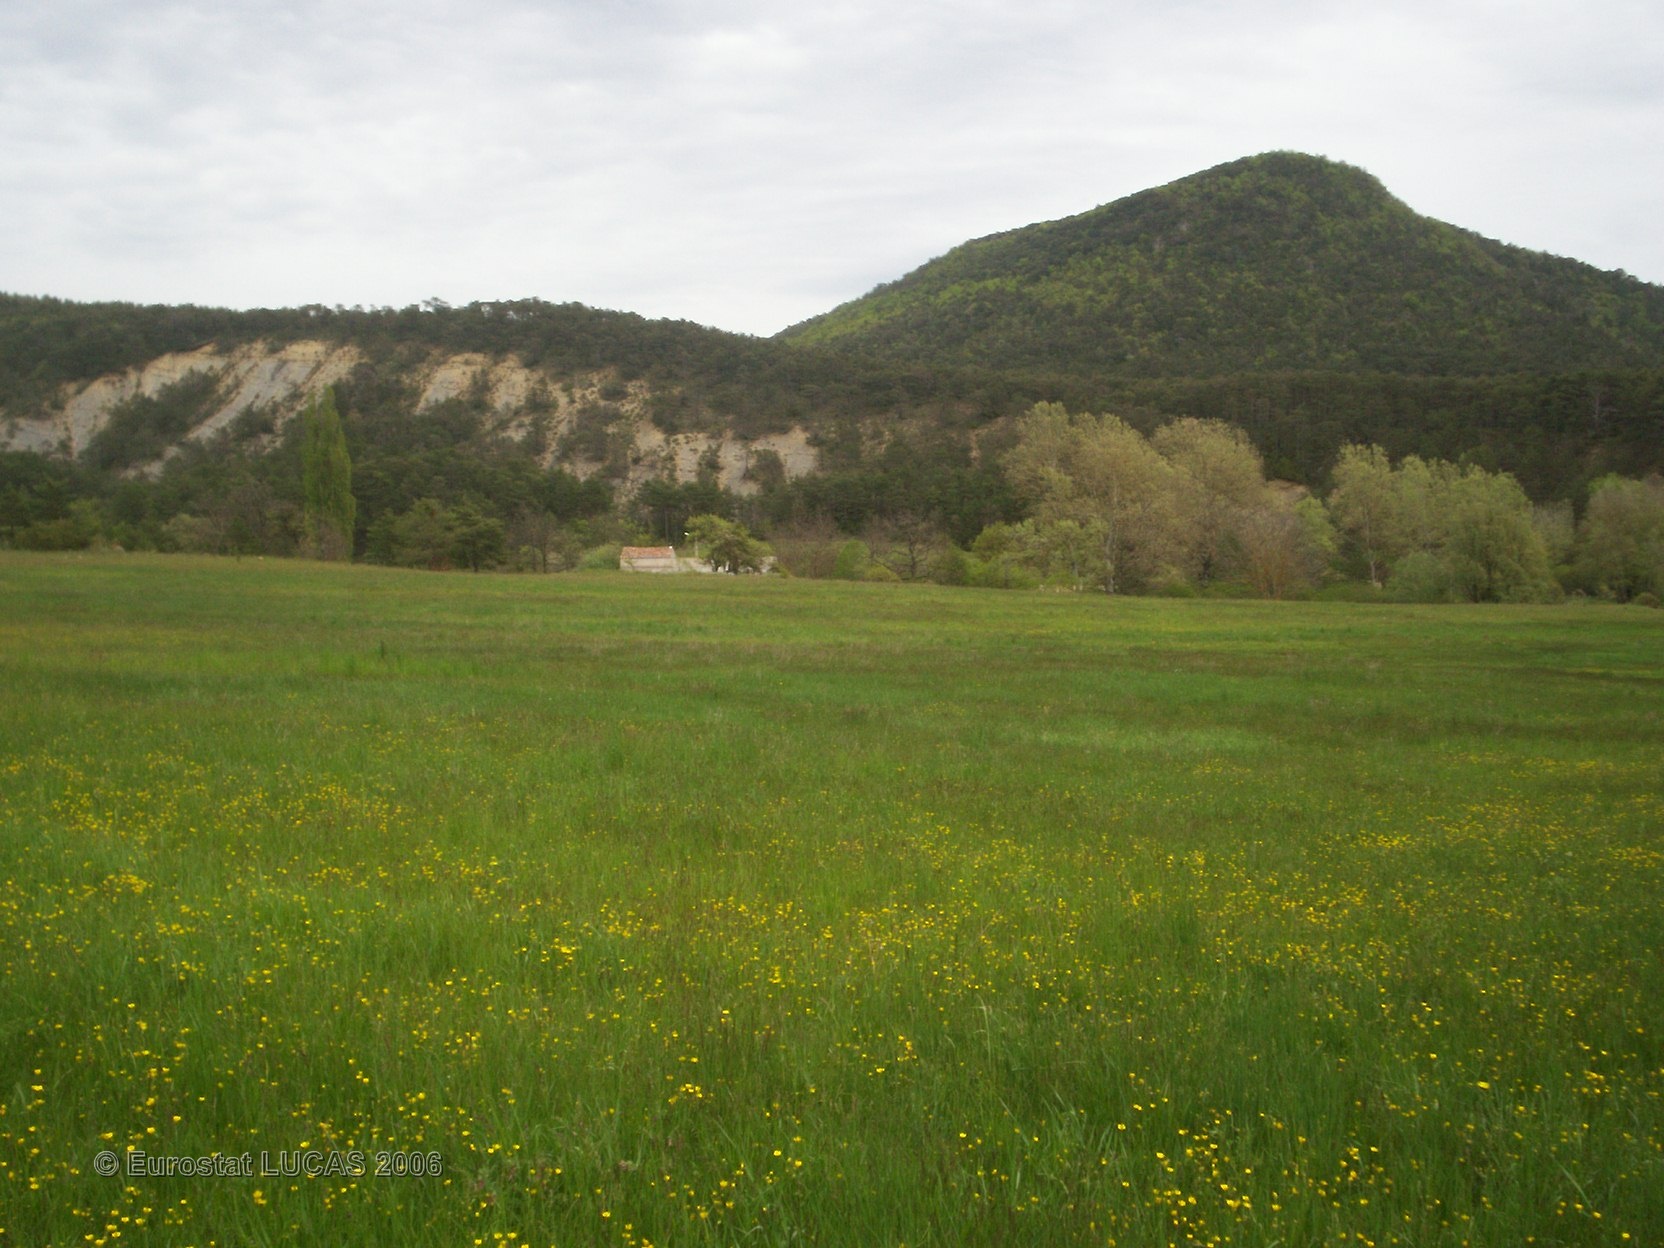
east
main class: Grassland
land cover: Grassland without tree/shrub cover
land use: Agriculture (excluding fallow land and kitchen gardens)
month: May
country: FR
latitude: 43.7865
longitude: 6.5160
